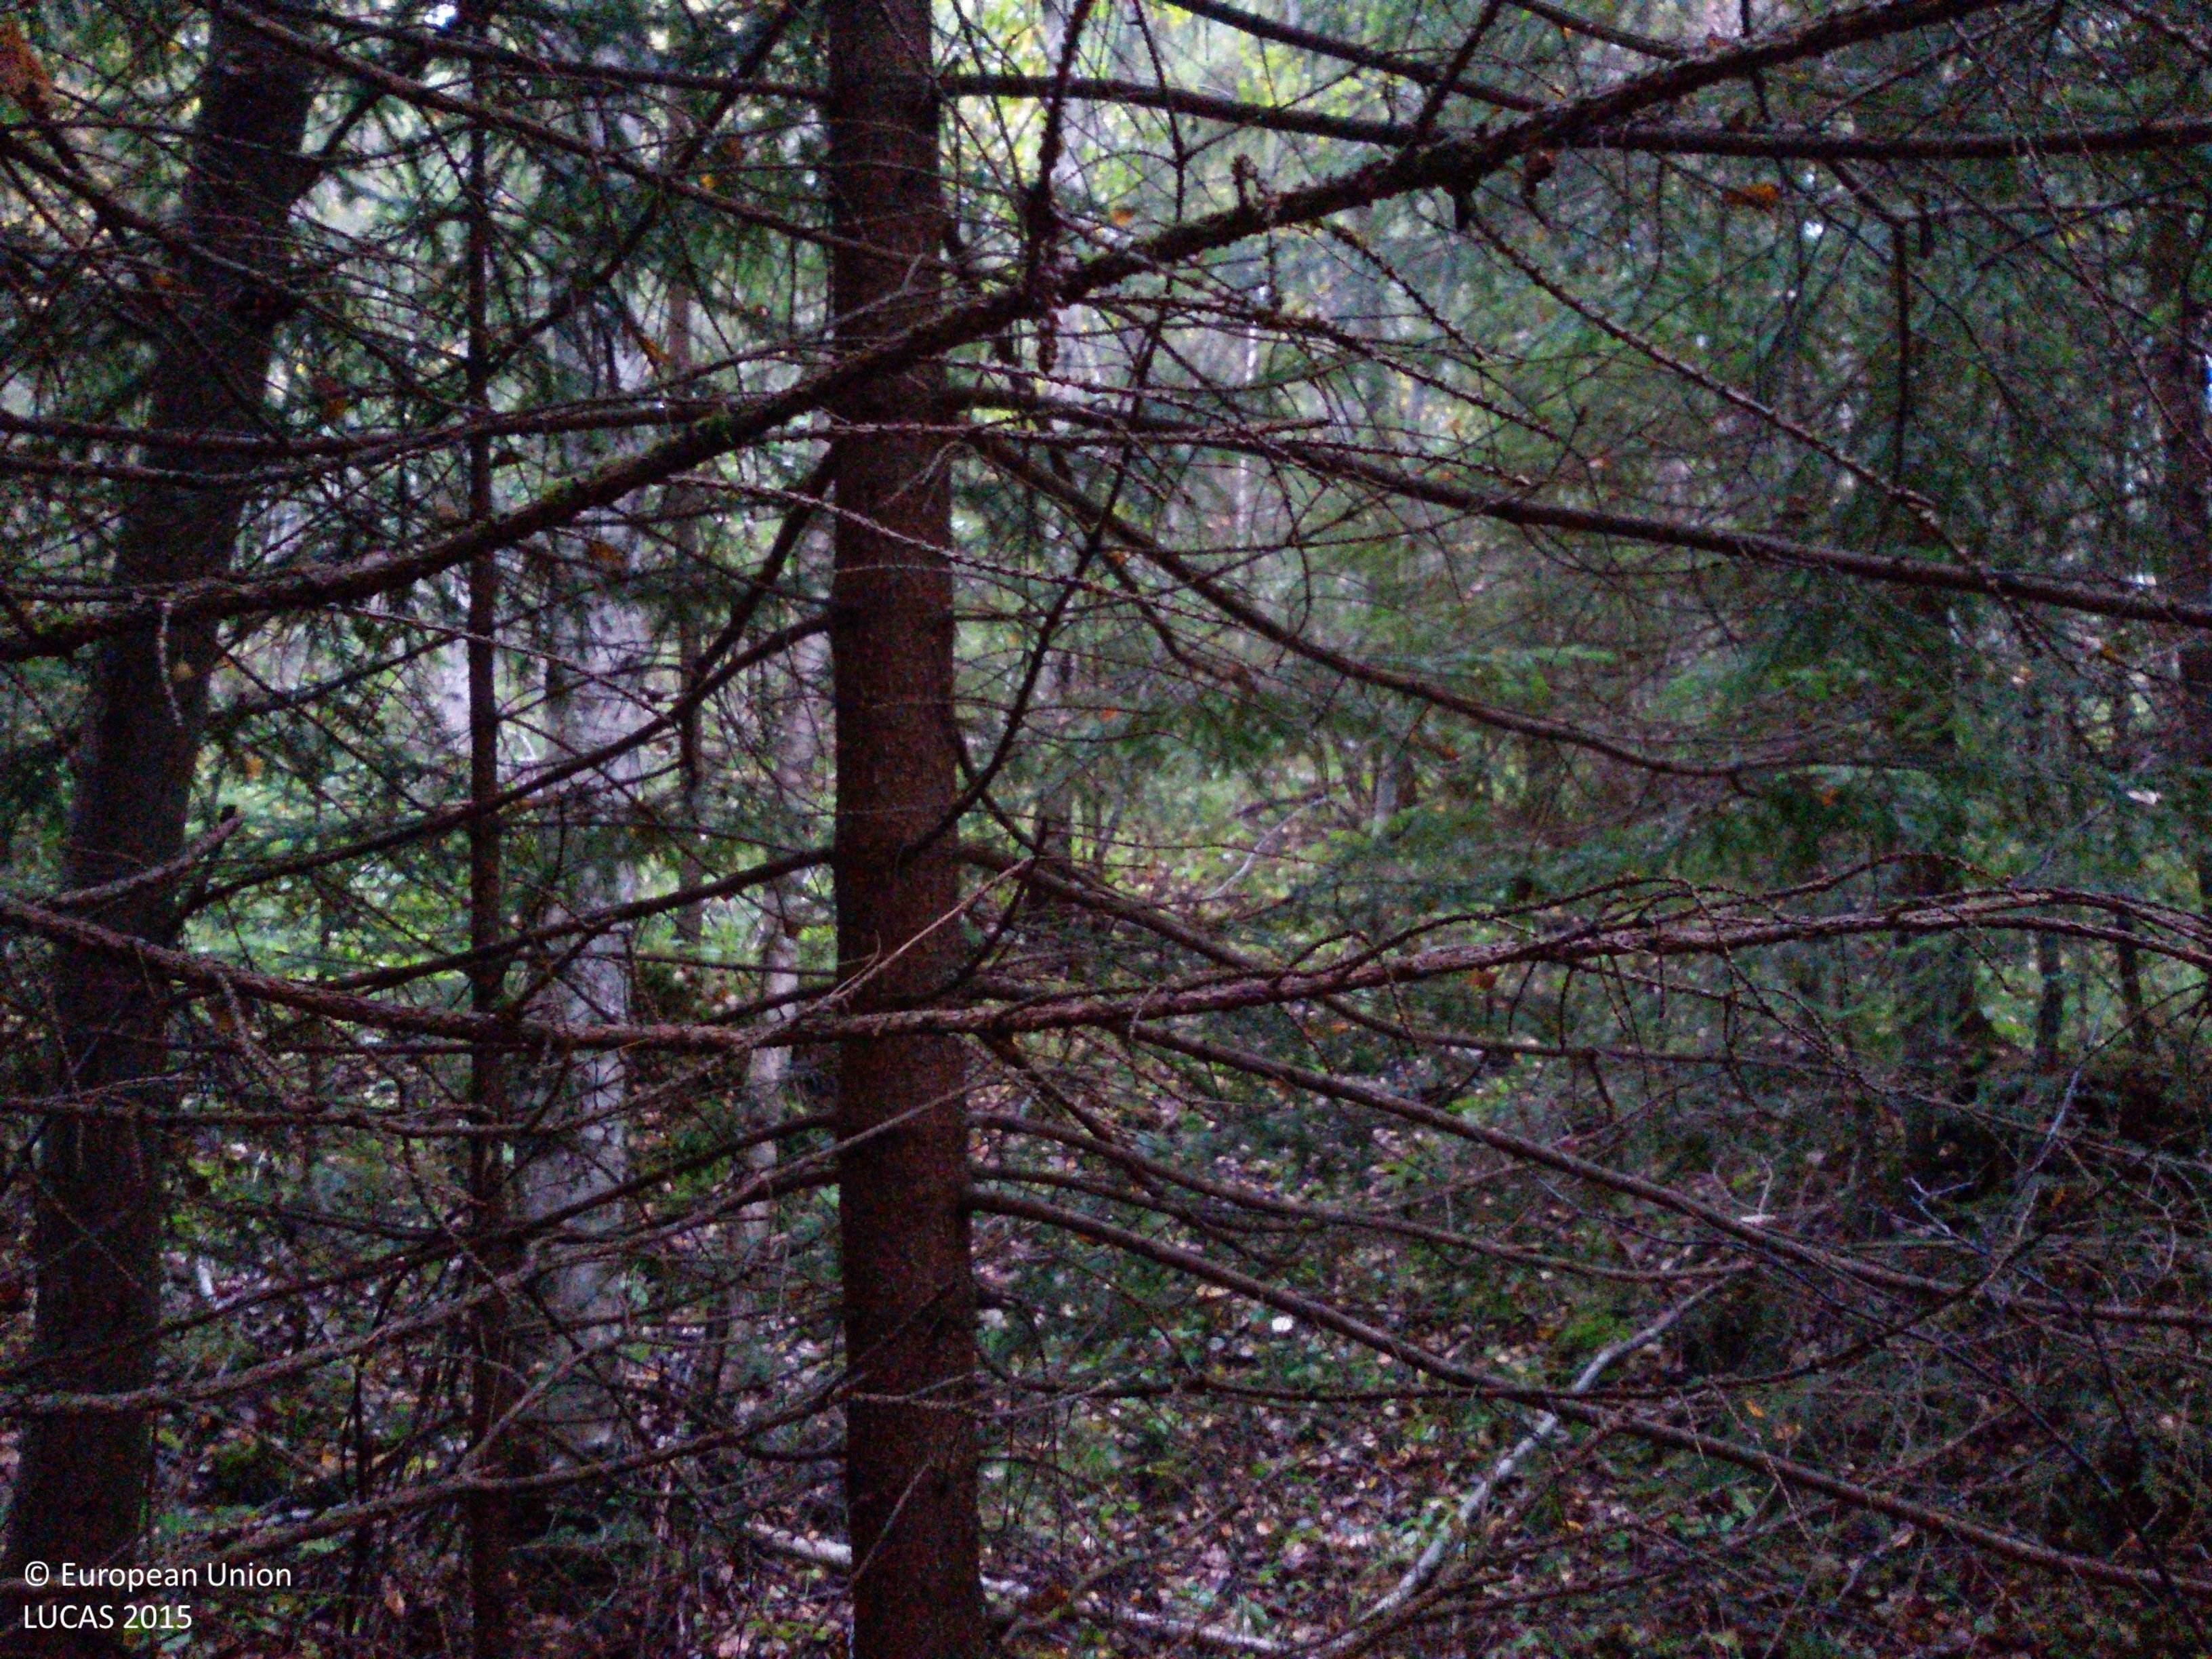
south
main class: Woodland
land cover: Spruce dominated mixed woodland
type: boreal forest
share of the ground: > 75 %
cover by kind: coniferous forest trees 55 %, broadleaved forest trees 35 %, herbaceous plants 10 %
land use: Forestry
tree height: > 5 m
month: September
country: SE
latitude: 60.7097
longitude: 14.8797
